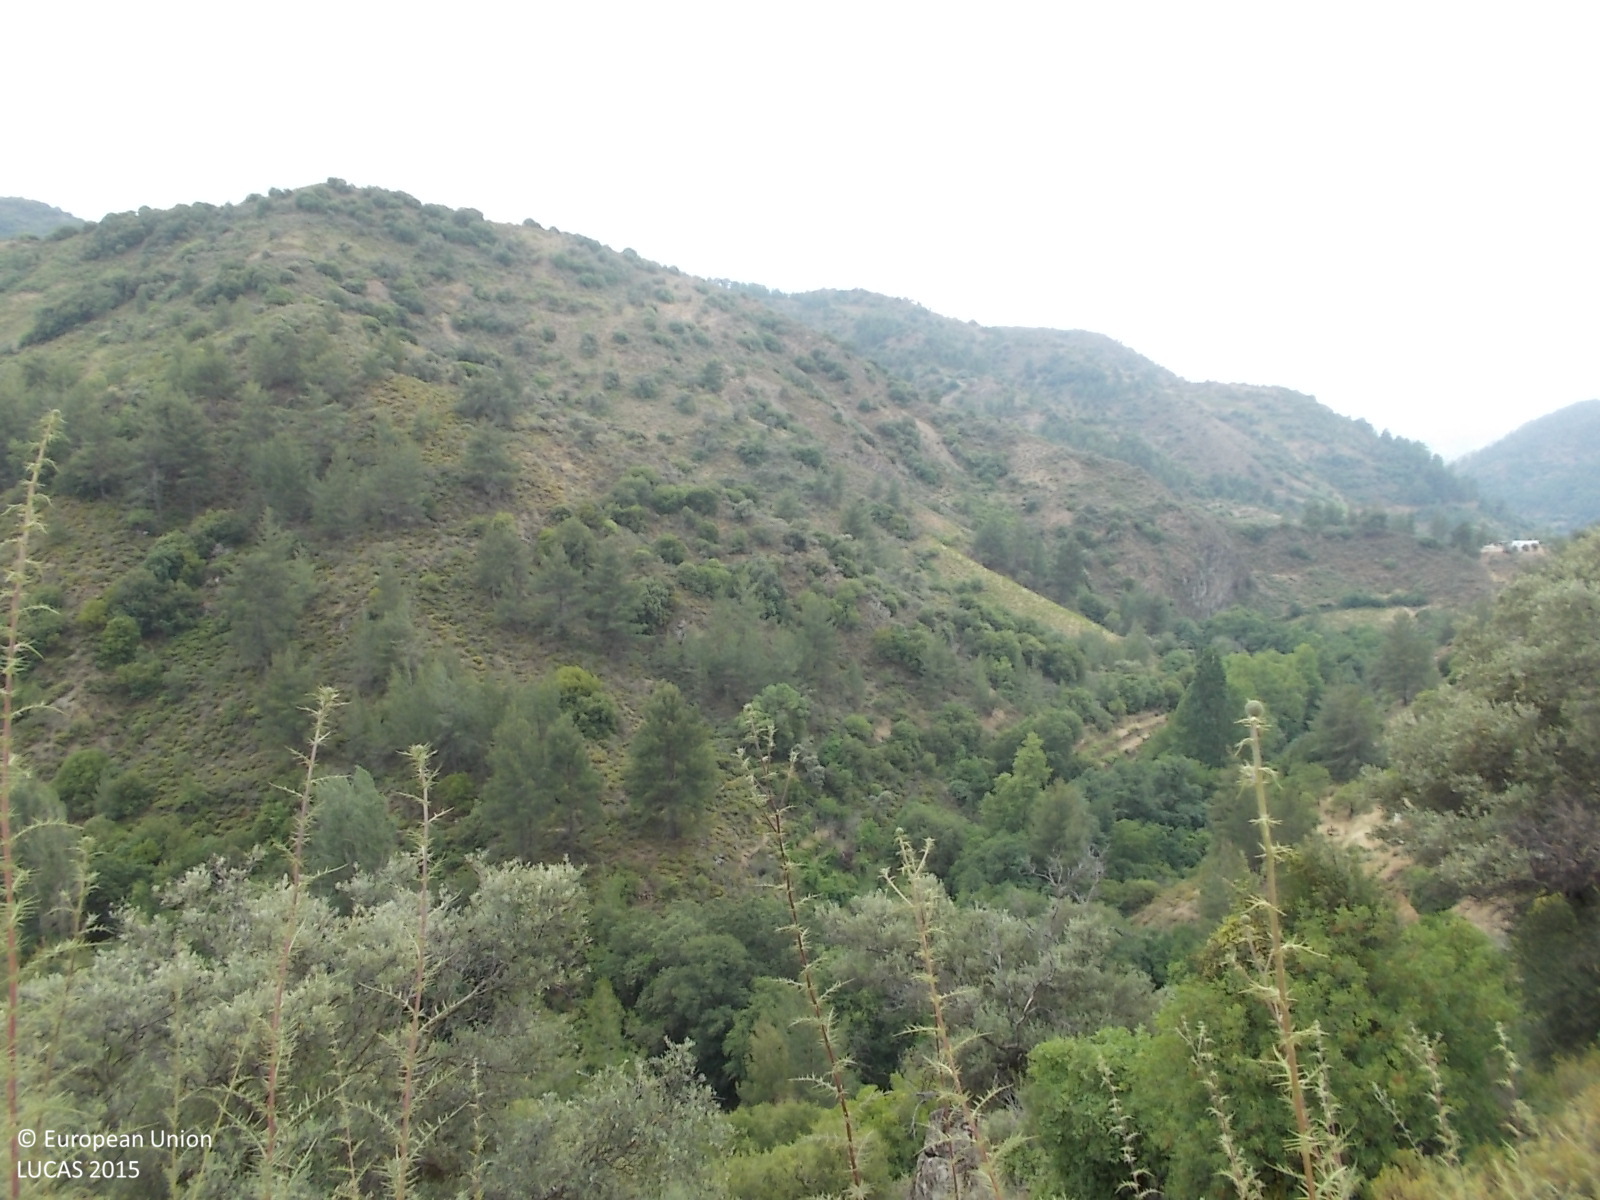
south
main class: Woodland
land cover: Pine dominated coniferous woodland
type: coniferous forest of the mediterranean region
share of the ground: 10 - 25 %
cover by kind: shrubs 35 %, coniferous forest trees 25 %, unconsolidated bare surface 25 %, herbaceous plants 15 %
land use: Forestry
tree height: > 5 m
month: June
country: CY
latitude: 34.9225
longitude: 32.7895
